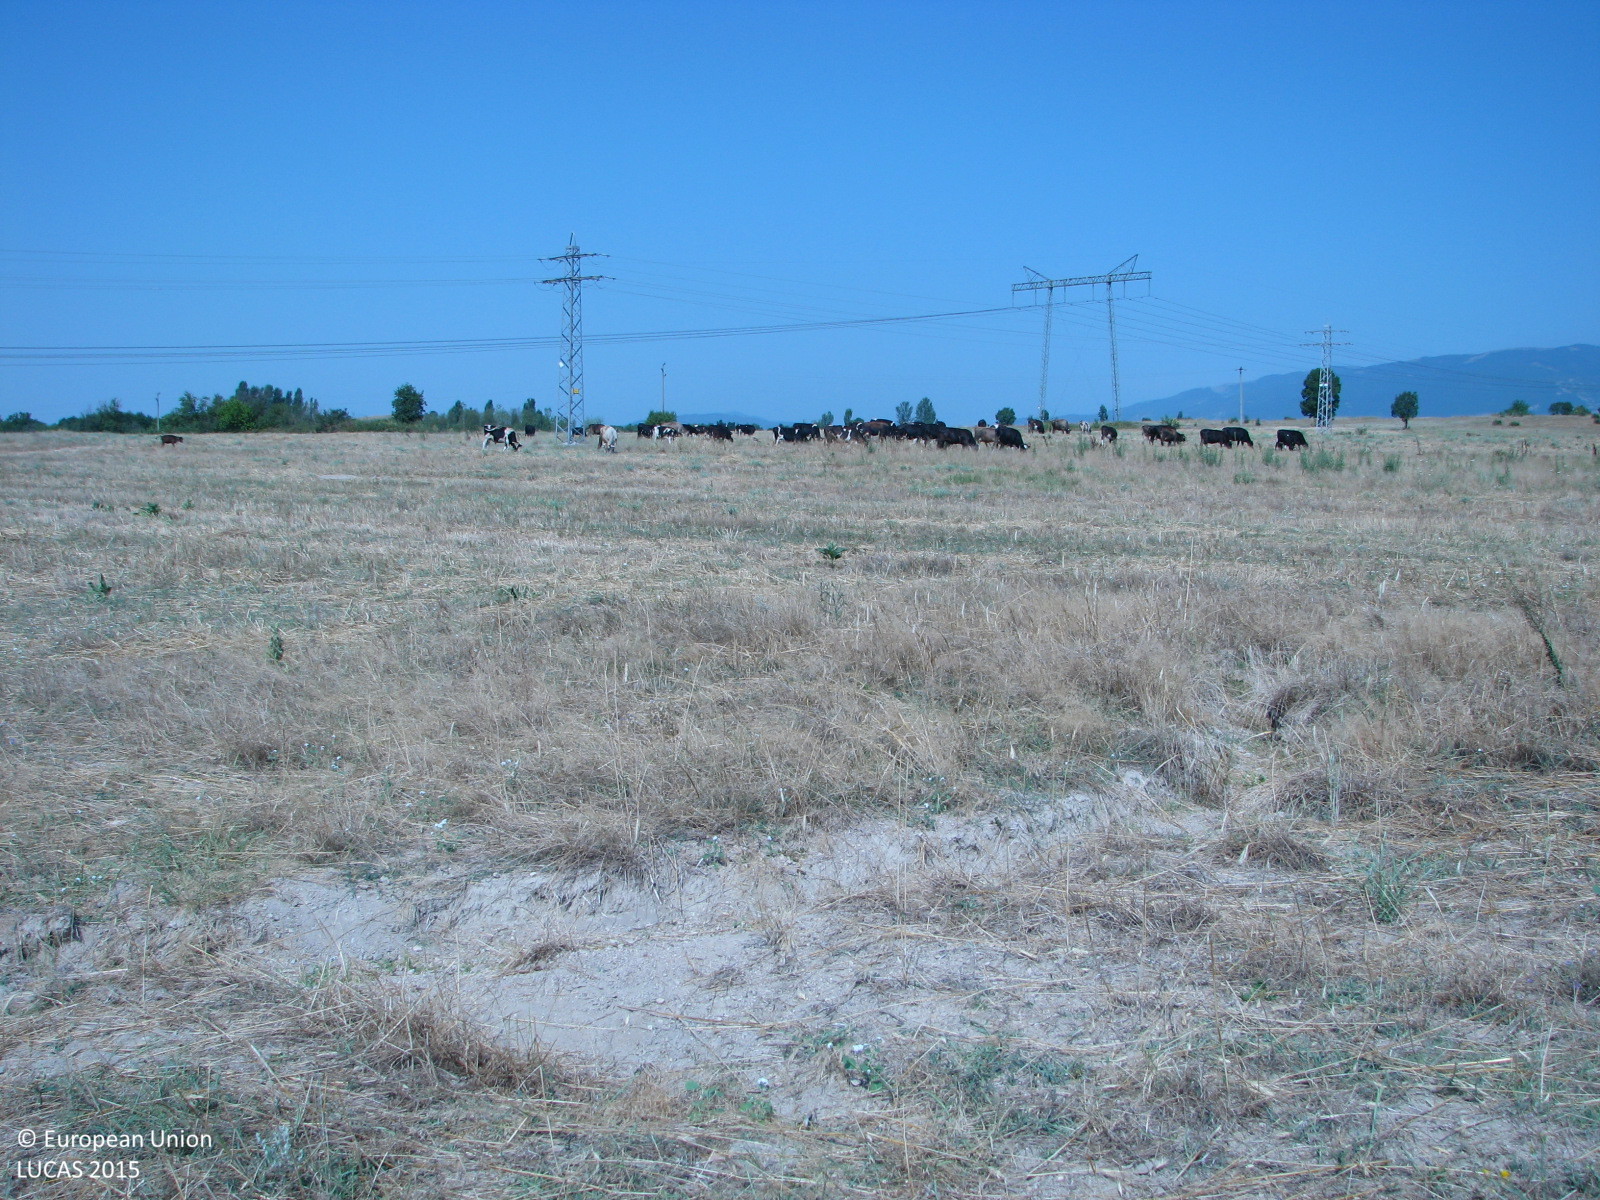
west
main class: Cropland
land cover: Rye
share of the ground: > 75 %
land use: Agriculture (excluding fallow land and kitchen gardens)
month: July
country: BG
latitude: 42.6657
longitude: 25.9551
